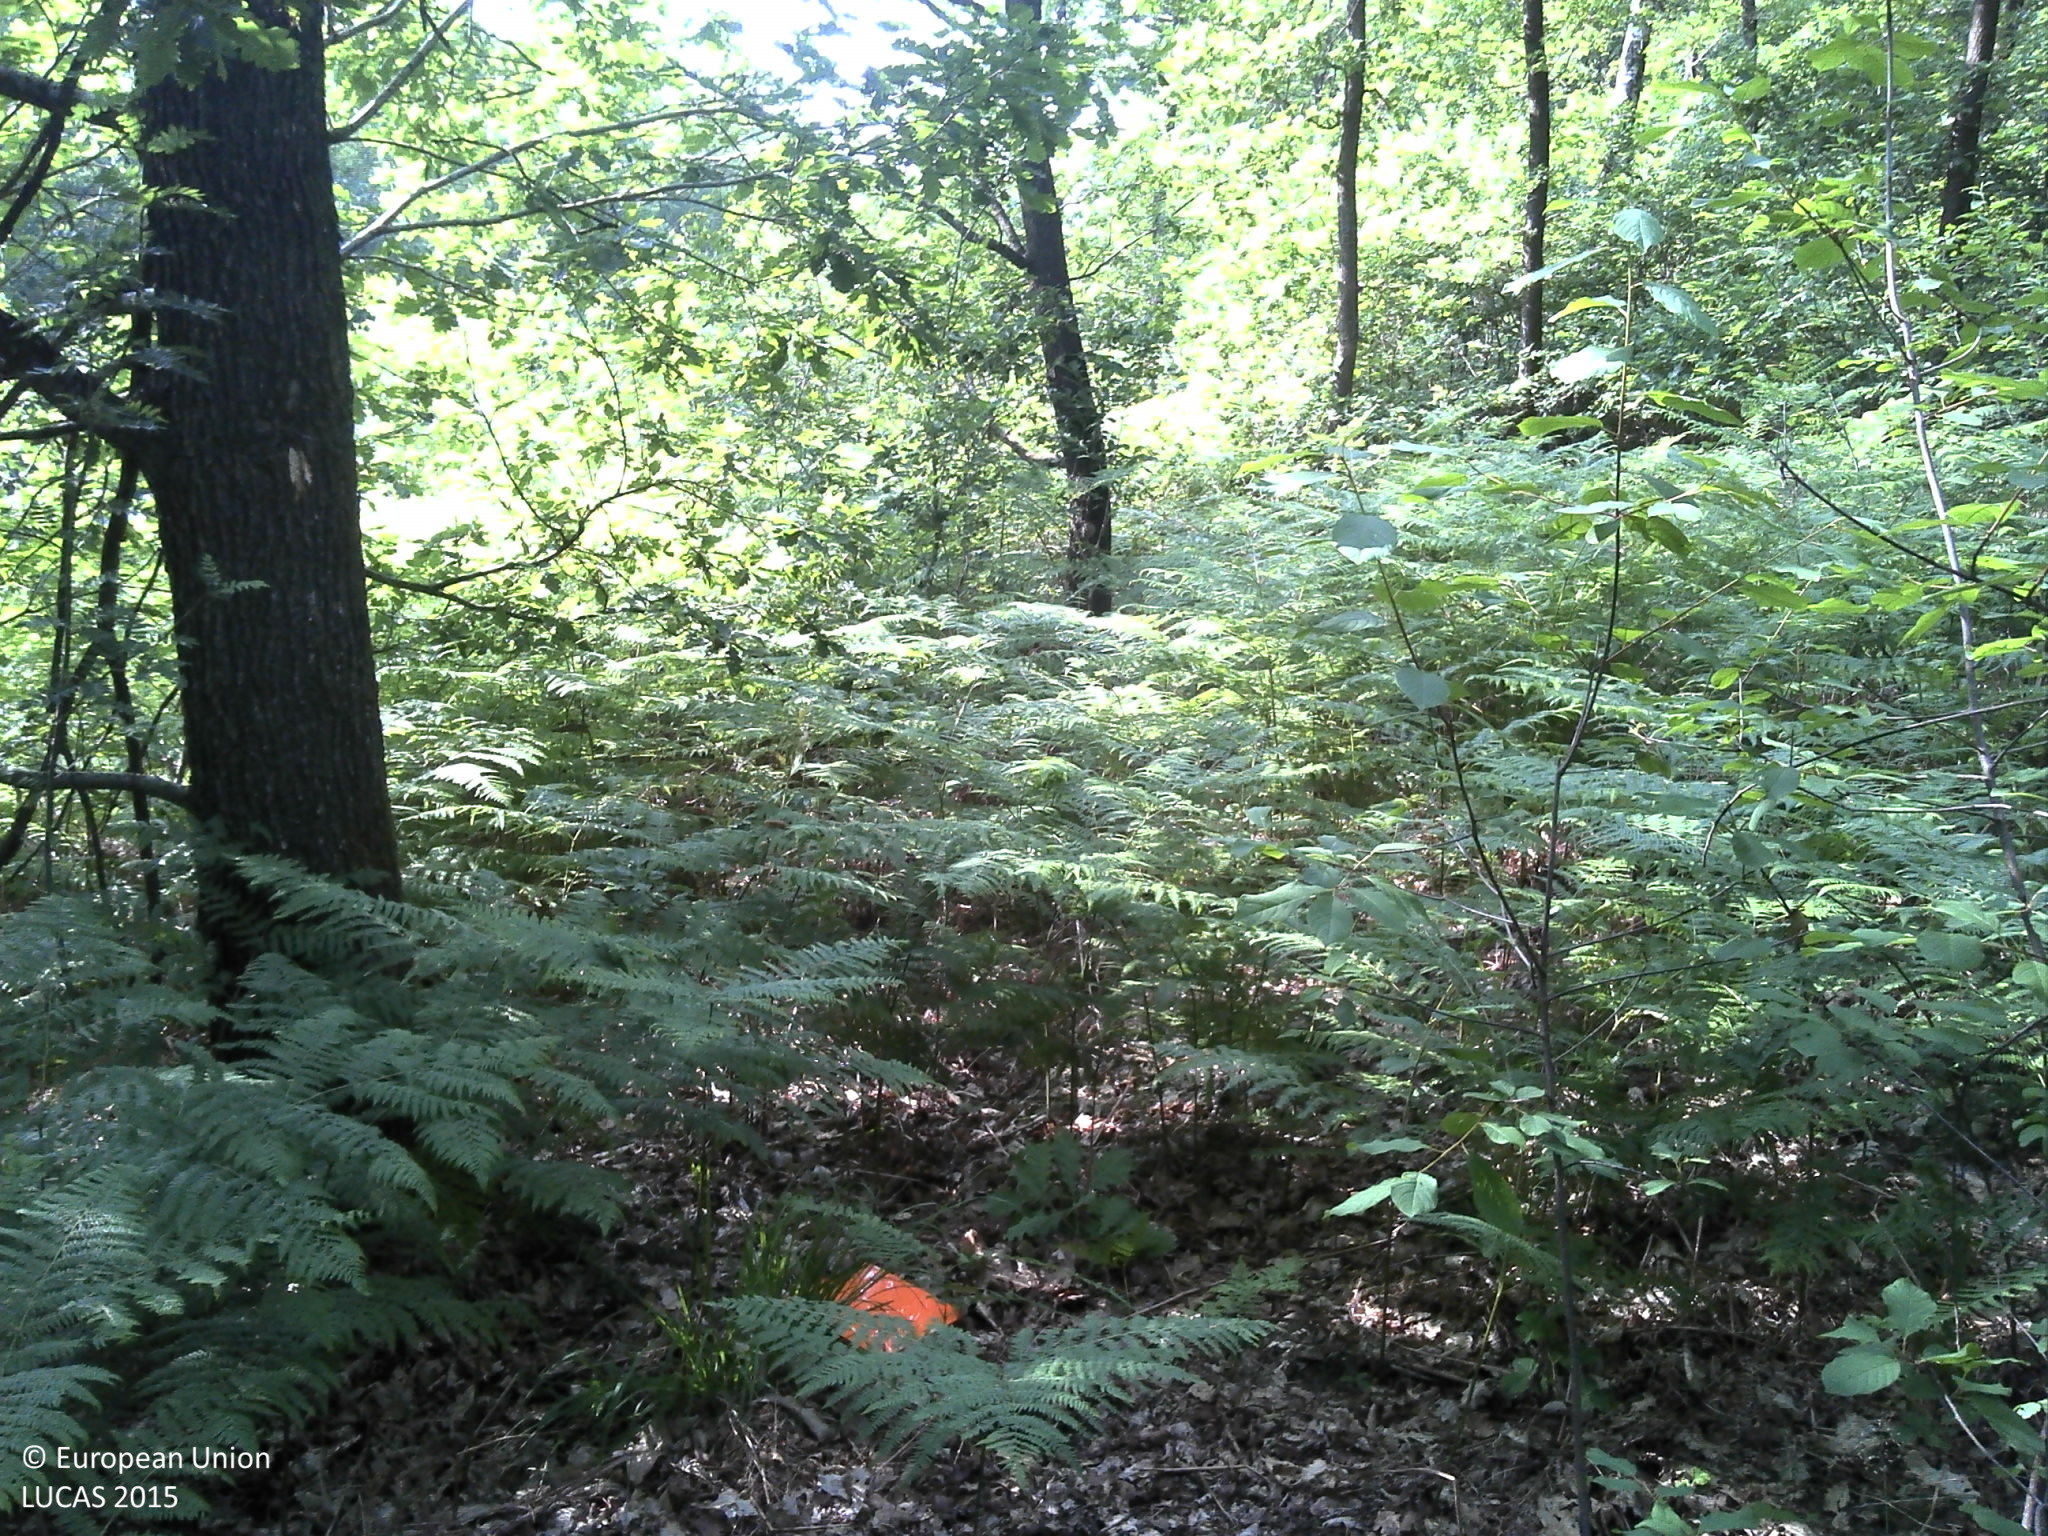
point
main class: Woodland
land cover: Broadleaved woodland
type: acidophilous oak and oak-birch forest
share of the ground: 50 - 75 %
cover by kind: broadleaved forest trees 65 %, herbaceous plants 25 %, consolidated bare surface 10 %
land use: Forestry
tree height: > 5 m
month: July
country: FR
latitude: 49.8779
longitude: 4.6389
